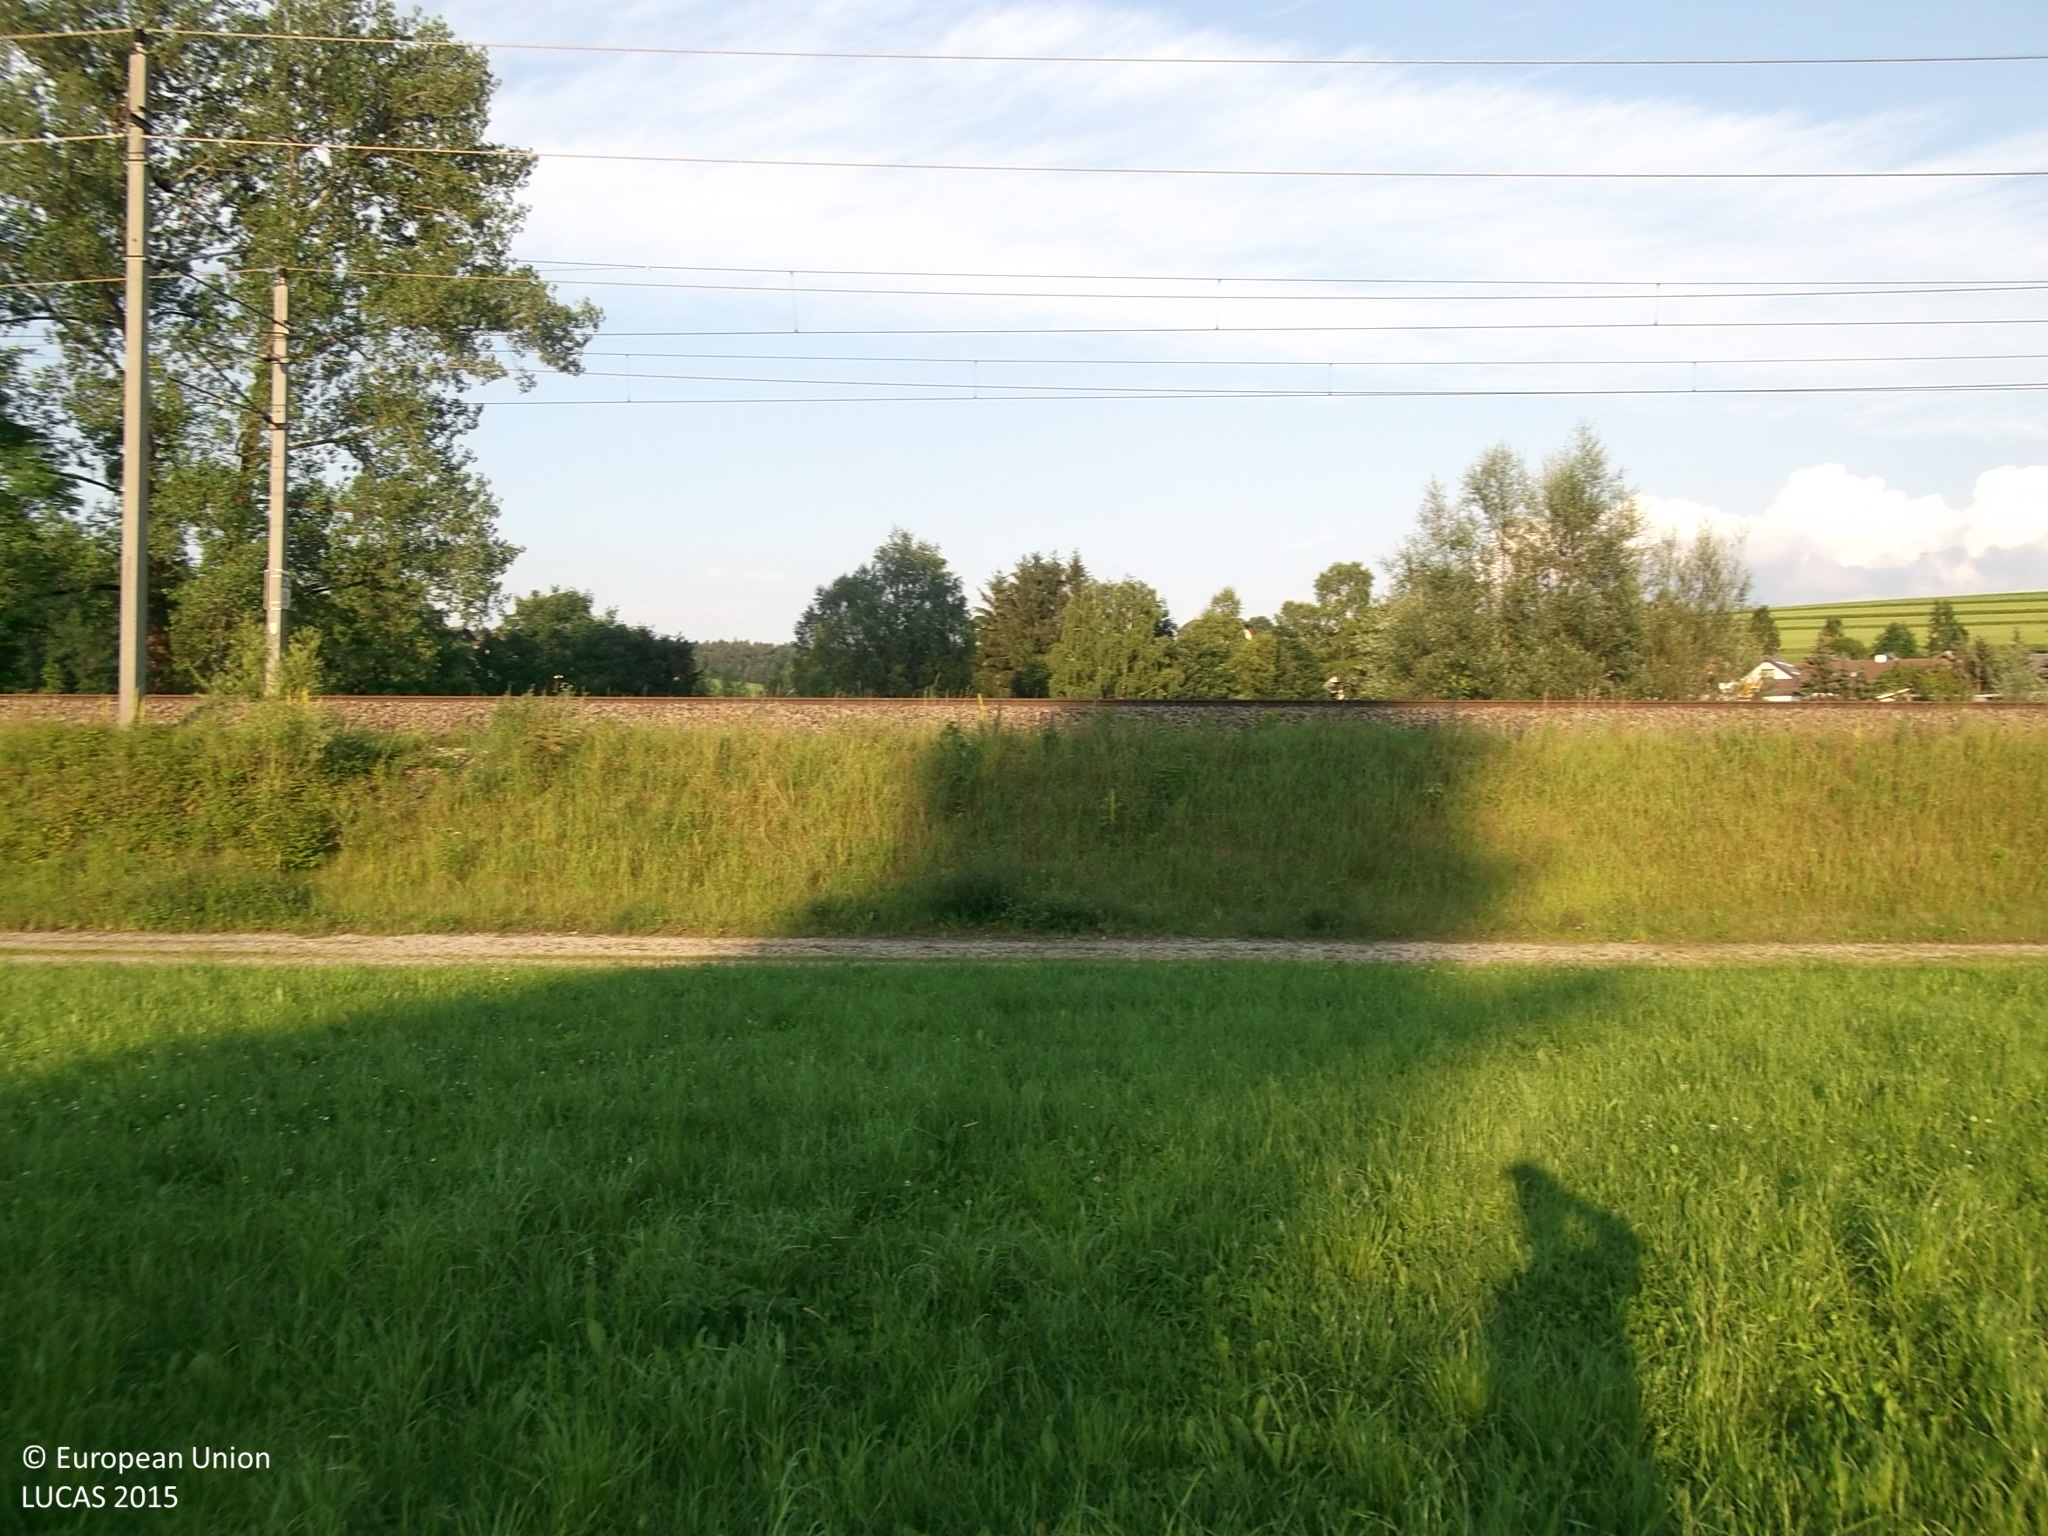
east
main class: Grassland
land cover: Grassland without tree/shrub cover
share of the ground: > 75 %
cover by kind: herbaceous plants 100 %
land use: Agriculture (excluding fallow land and kitchen gardens)
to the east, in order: Grassland without tree/shrub cover; Tracks; Grassland without tree/shrub cover; Electric lines; Railways; Shrubland without tree cover; Grassland without tree/shrub cover; Broadleaved woodland; Rivers and streams; Broadleaved woodland; Grassland without tree/shrub cover; Single bushes/trees; Grassland without tree/shrub cover
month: June
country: AT
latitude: 48.0060
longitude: 13.4975
